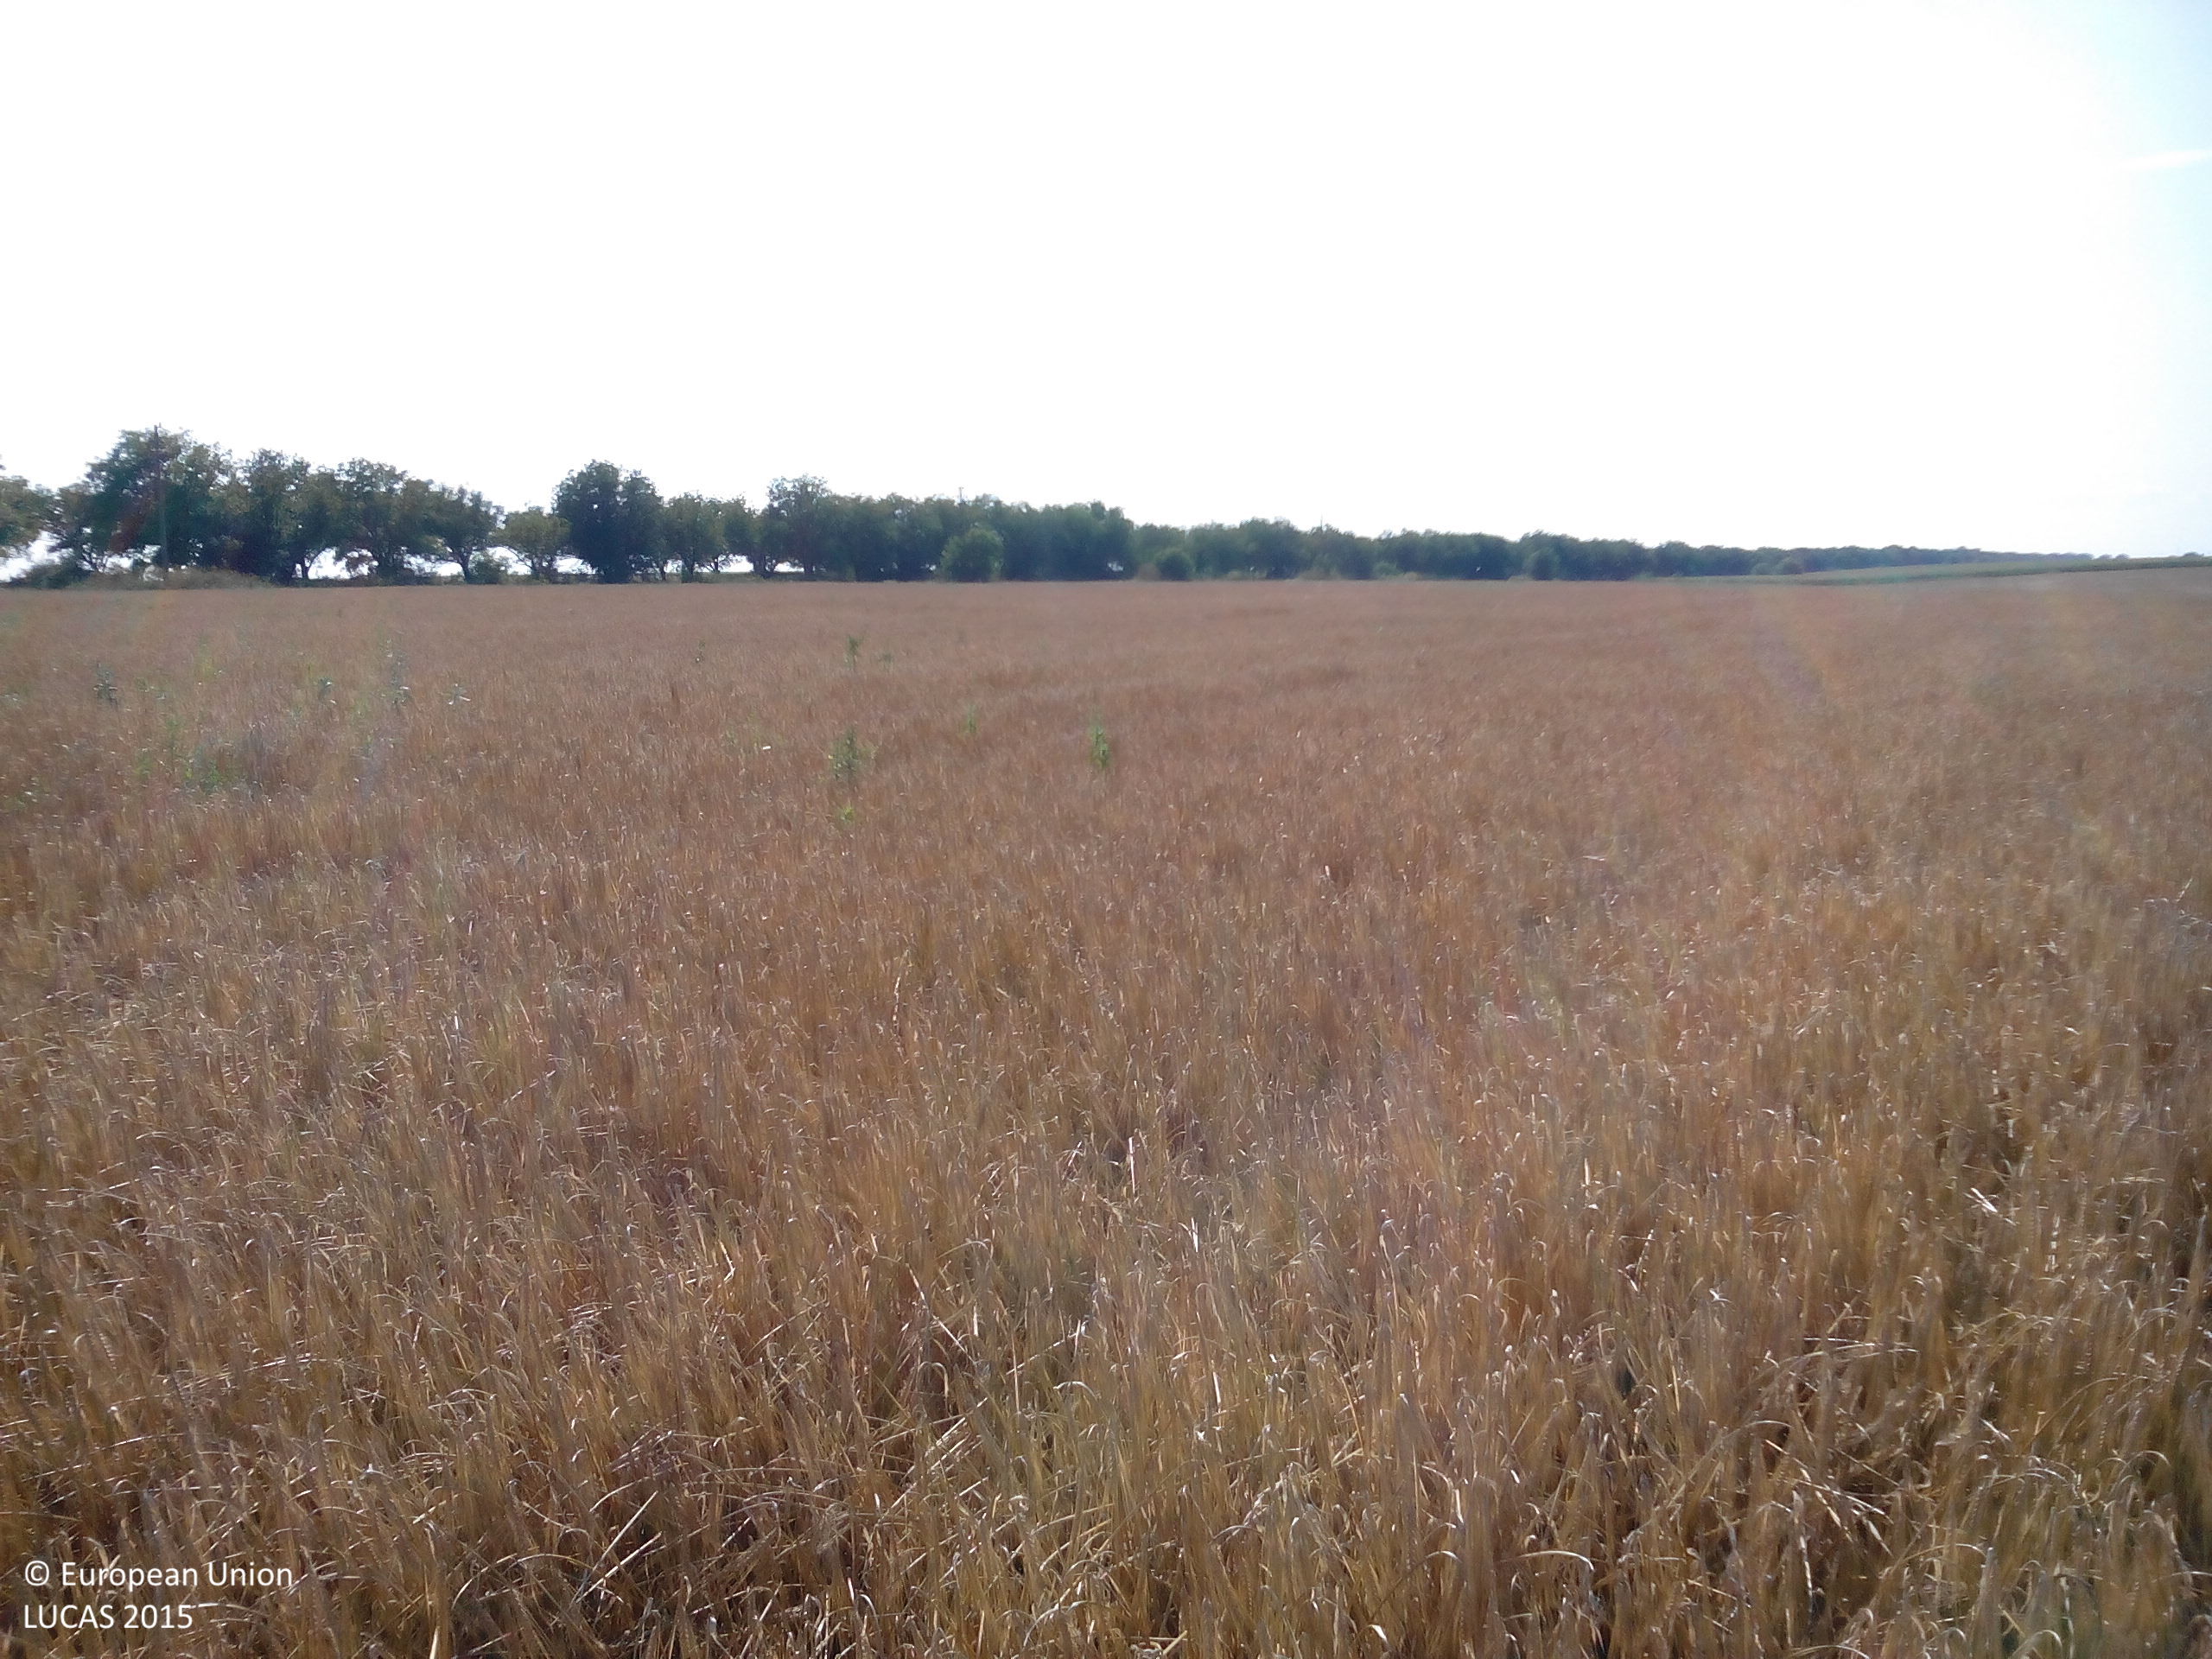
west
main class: Cropland
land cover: Barley
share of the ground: > 75 %
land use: Agriculture (excluding fallow land and kitchen gardens)
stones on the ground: < 10 %
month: July
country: BG
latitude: 43.4382
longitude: 24.3529
